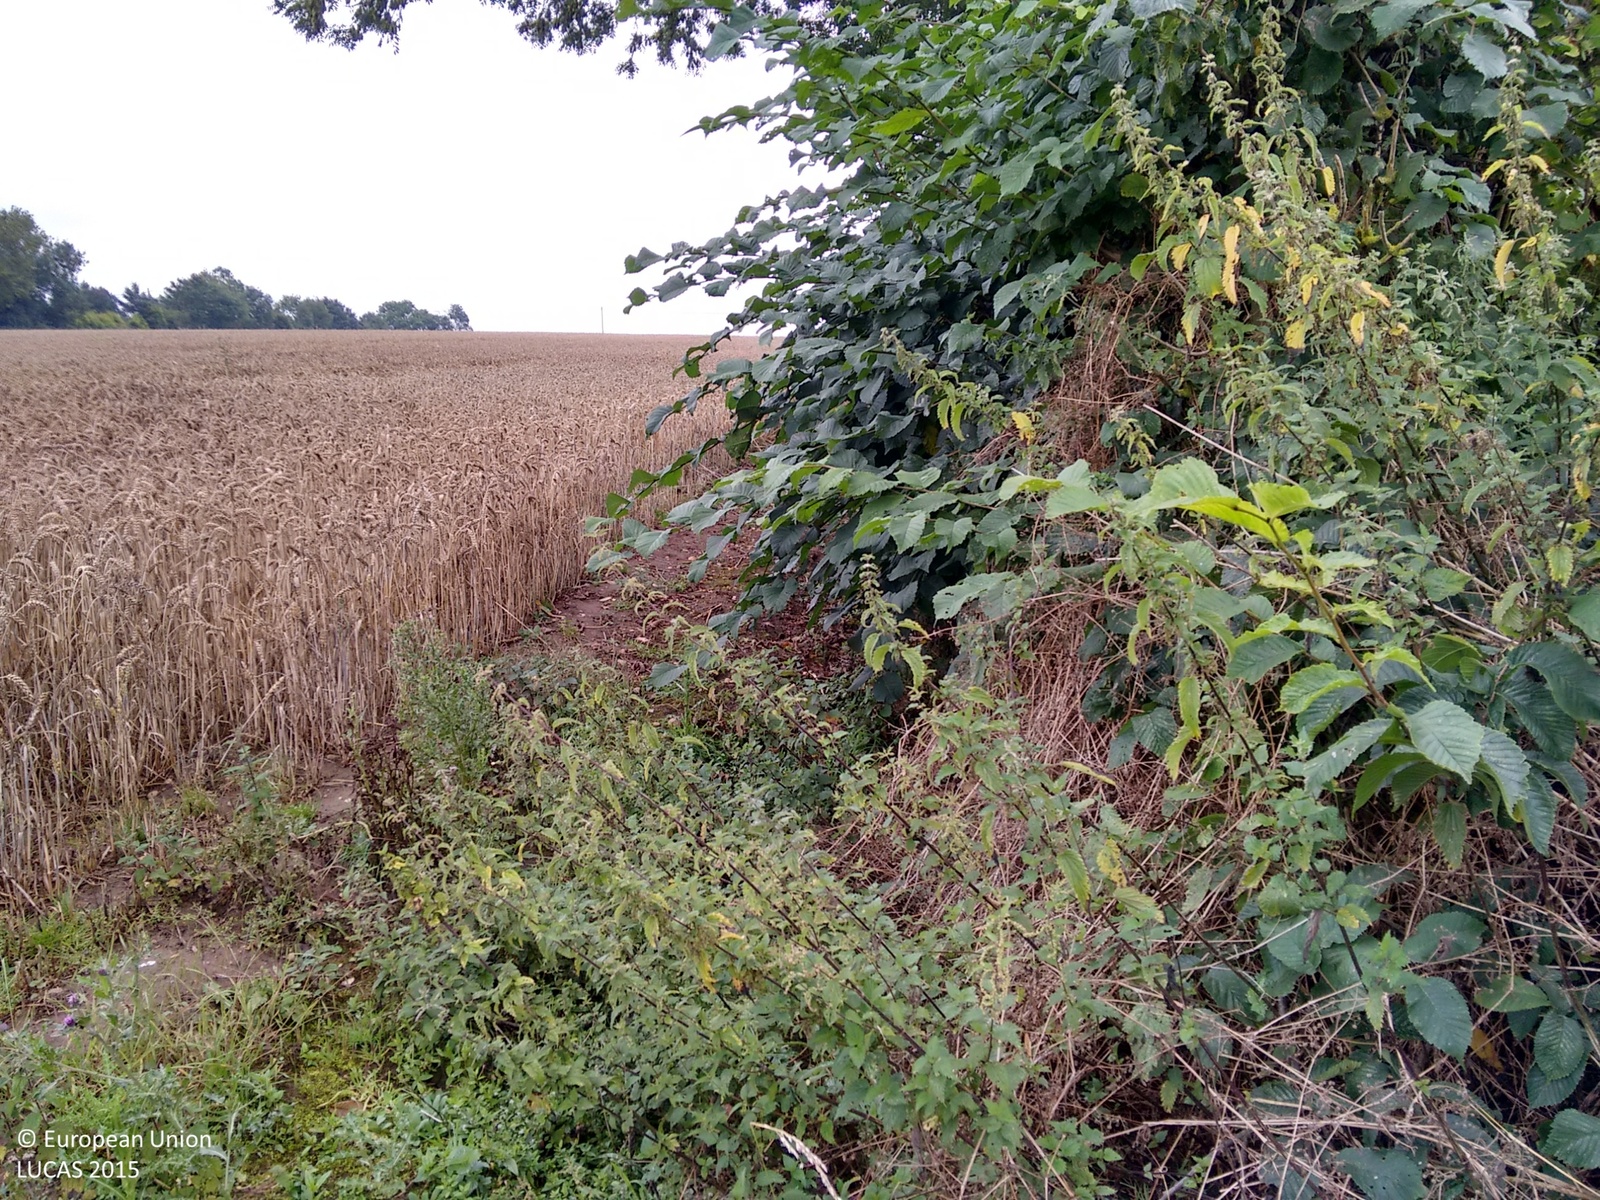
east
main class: Grassland
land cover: Grassland without tree/shrub cover
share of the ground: > 75 %
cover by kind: herbaceous plants 100 %
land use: Agriculture (excluding fallow land and kitchen gardens)
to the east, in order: Grassland without tree/shrub cover; Fences; Managed hedges; Grass margins; Paved roads, cycling and walking lanes; Grassland without tree/shrub cover; Electric lines; Abandoned hedges; Grassland without tree/shrub cover; Paved roads, cycling and walking lanes; Grass margins; Fences; Broadleaved woodland; Ditches and canals; Fences; Grassland without tree/shrub cover
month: September
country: GB
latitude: 52.5061
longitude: -1.3190
